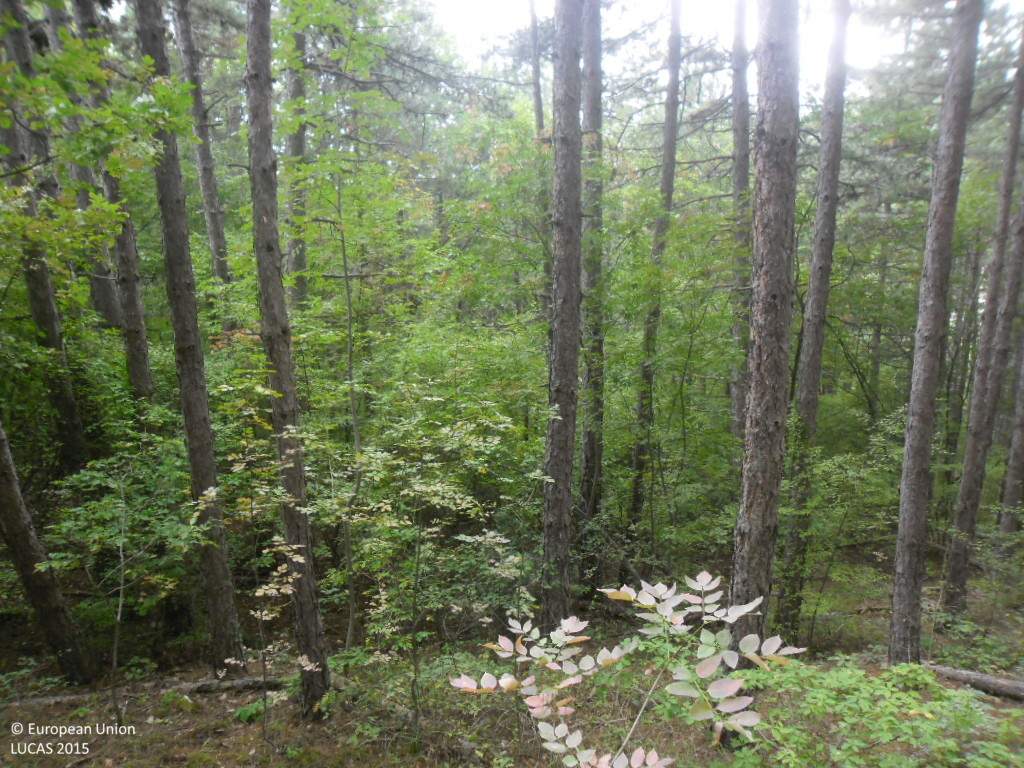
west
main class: Woodland
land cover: Pine dominated coniferous woodland
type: hemiboreal forest and nemoral coniferous forest and mixed broadleaved-coniferous forest
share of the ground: > 75 %
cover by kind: coniferous forest trees 95 %, unconsolidated bare surface 5 %
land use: Forestry
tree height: > 5 m
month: October
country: BG
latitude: 41.5558
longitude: 23.4162
